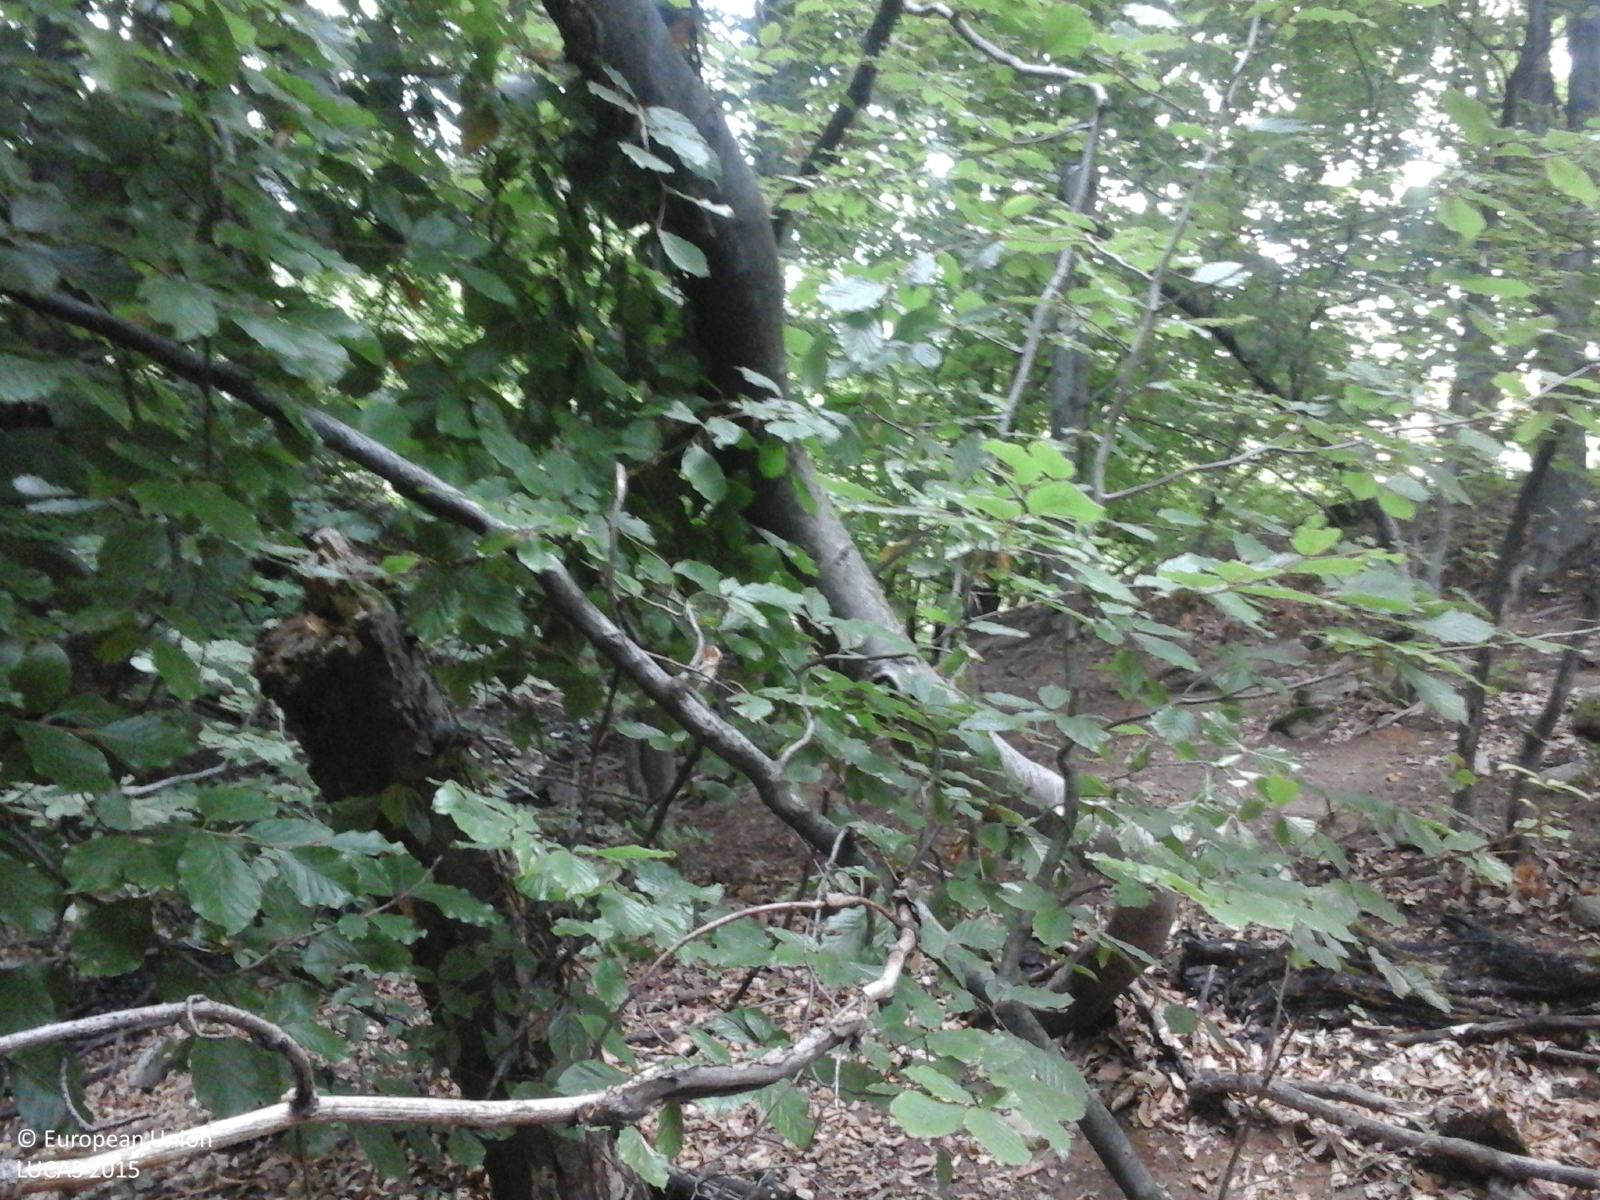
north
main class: Woodland
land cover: Broadleaved woodland
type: beech forest
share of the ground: > 75 %
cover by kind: broadleaved forest trees 100 %
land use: Forestry
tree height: > 5 m
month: September
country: RO
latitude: 47.8262
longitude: 23.5004
